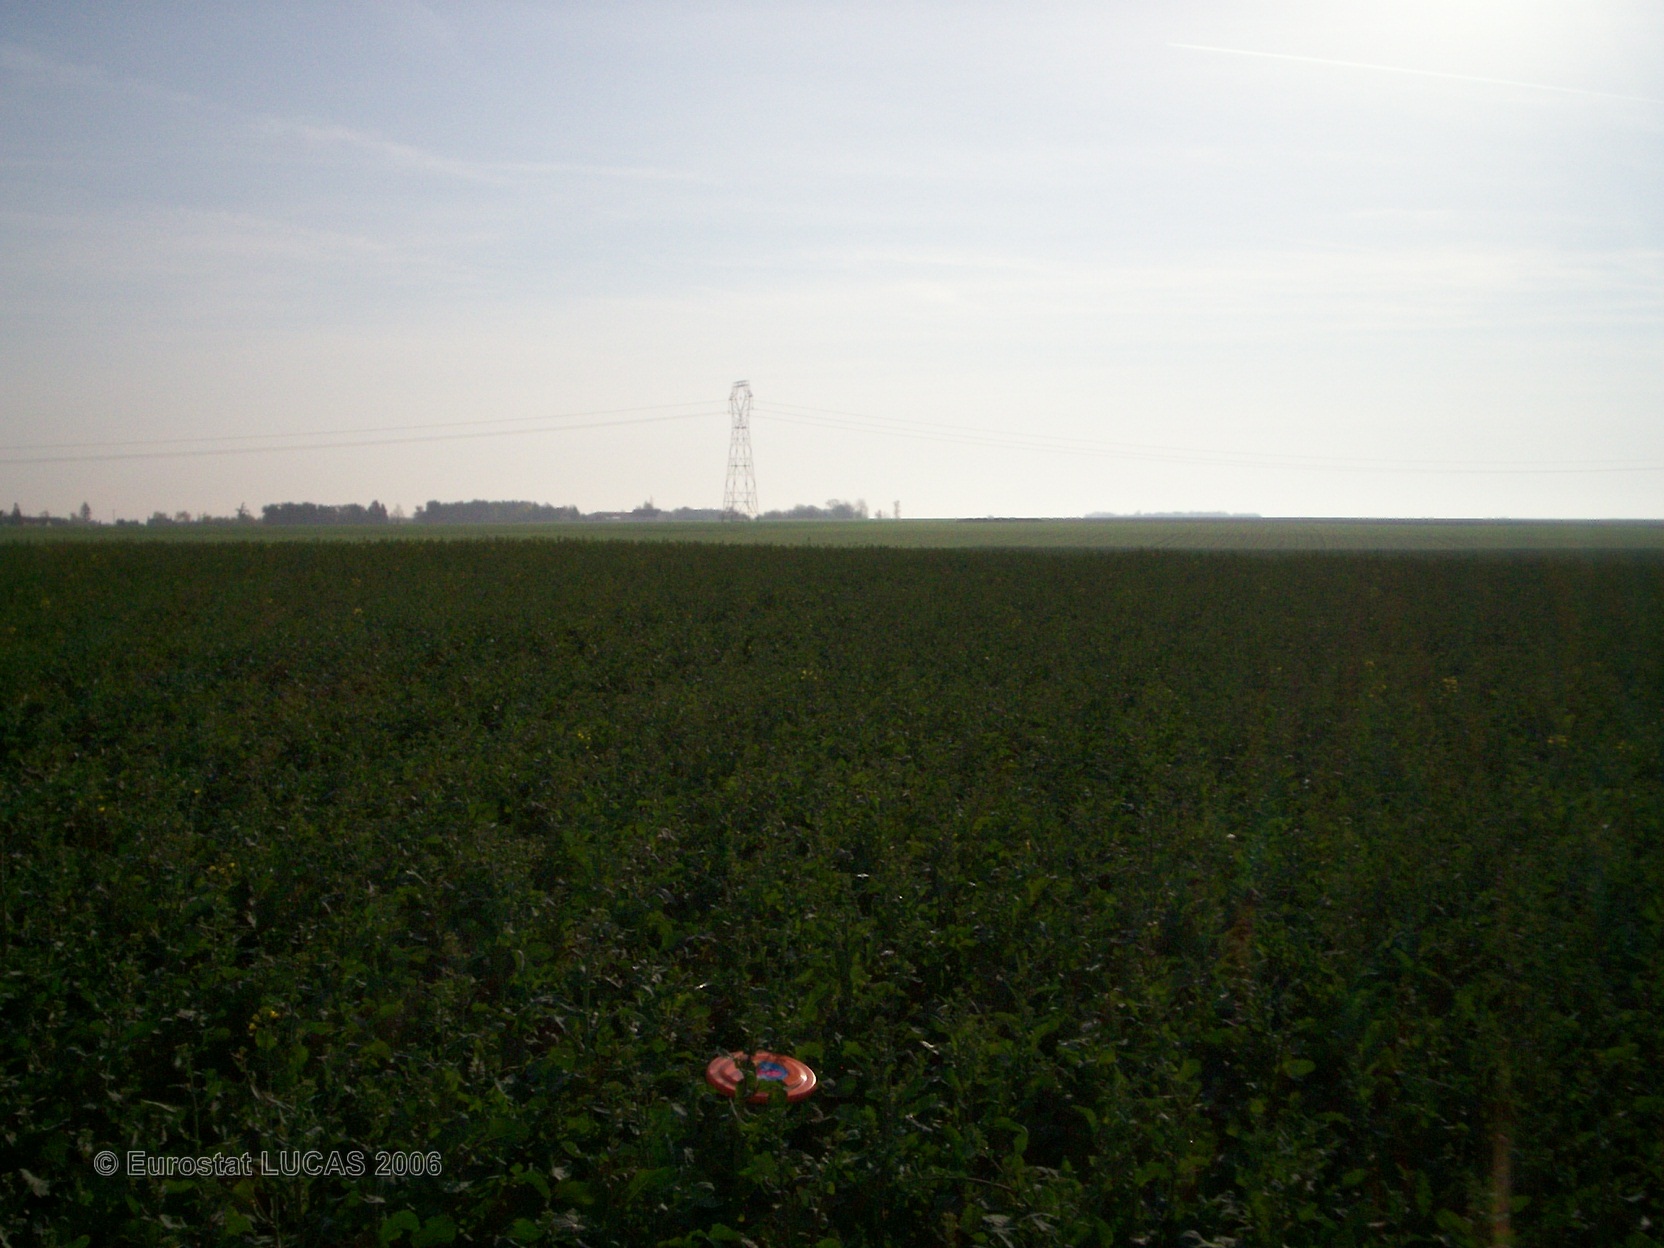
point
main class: Cropland
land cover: Rape and turnip rape
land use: Agriculture (excluding fallow land and kitchen gardens)
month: April
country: FR
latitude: 48.3366
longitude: 2.8822
